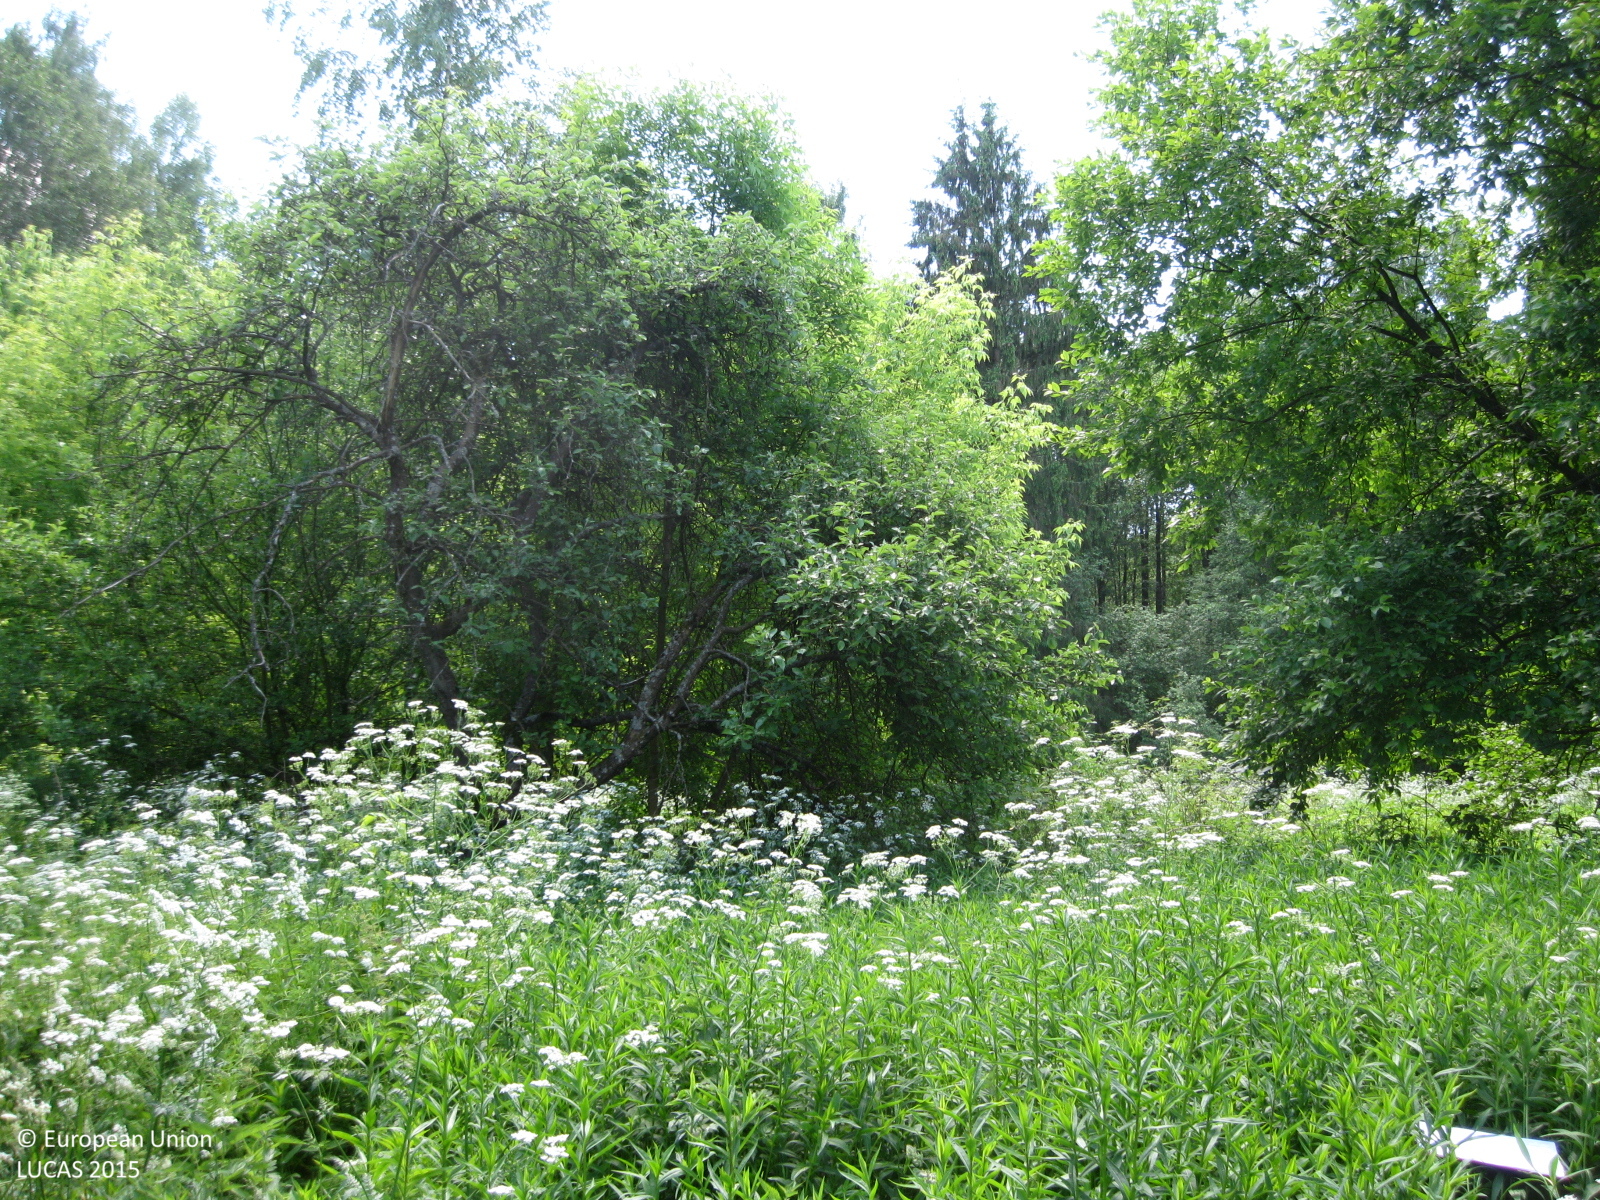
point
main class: Grassland
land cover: Spontaneously vegetated surfaces
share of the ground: > 75 %
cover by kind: herbaceous plants 100 %
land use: Semi-natural and natural areas not in use
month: June
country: LT
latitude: 55.3474
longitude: 23.9502
